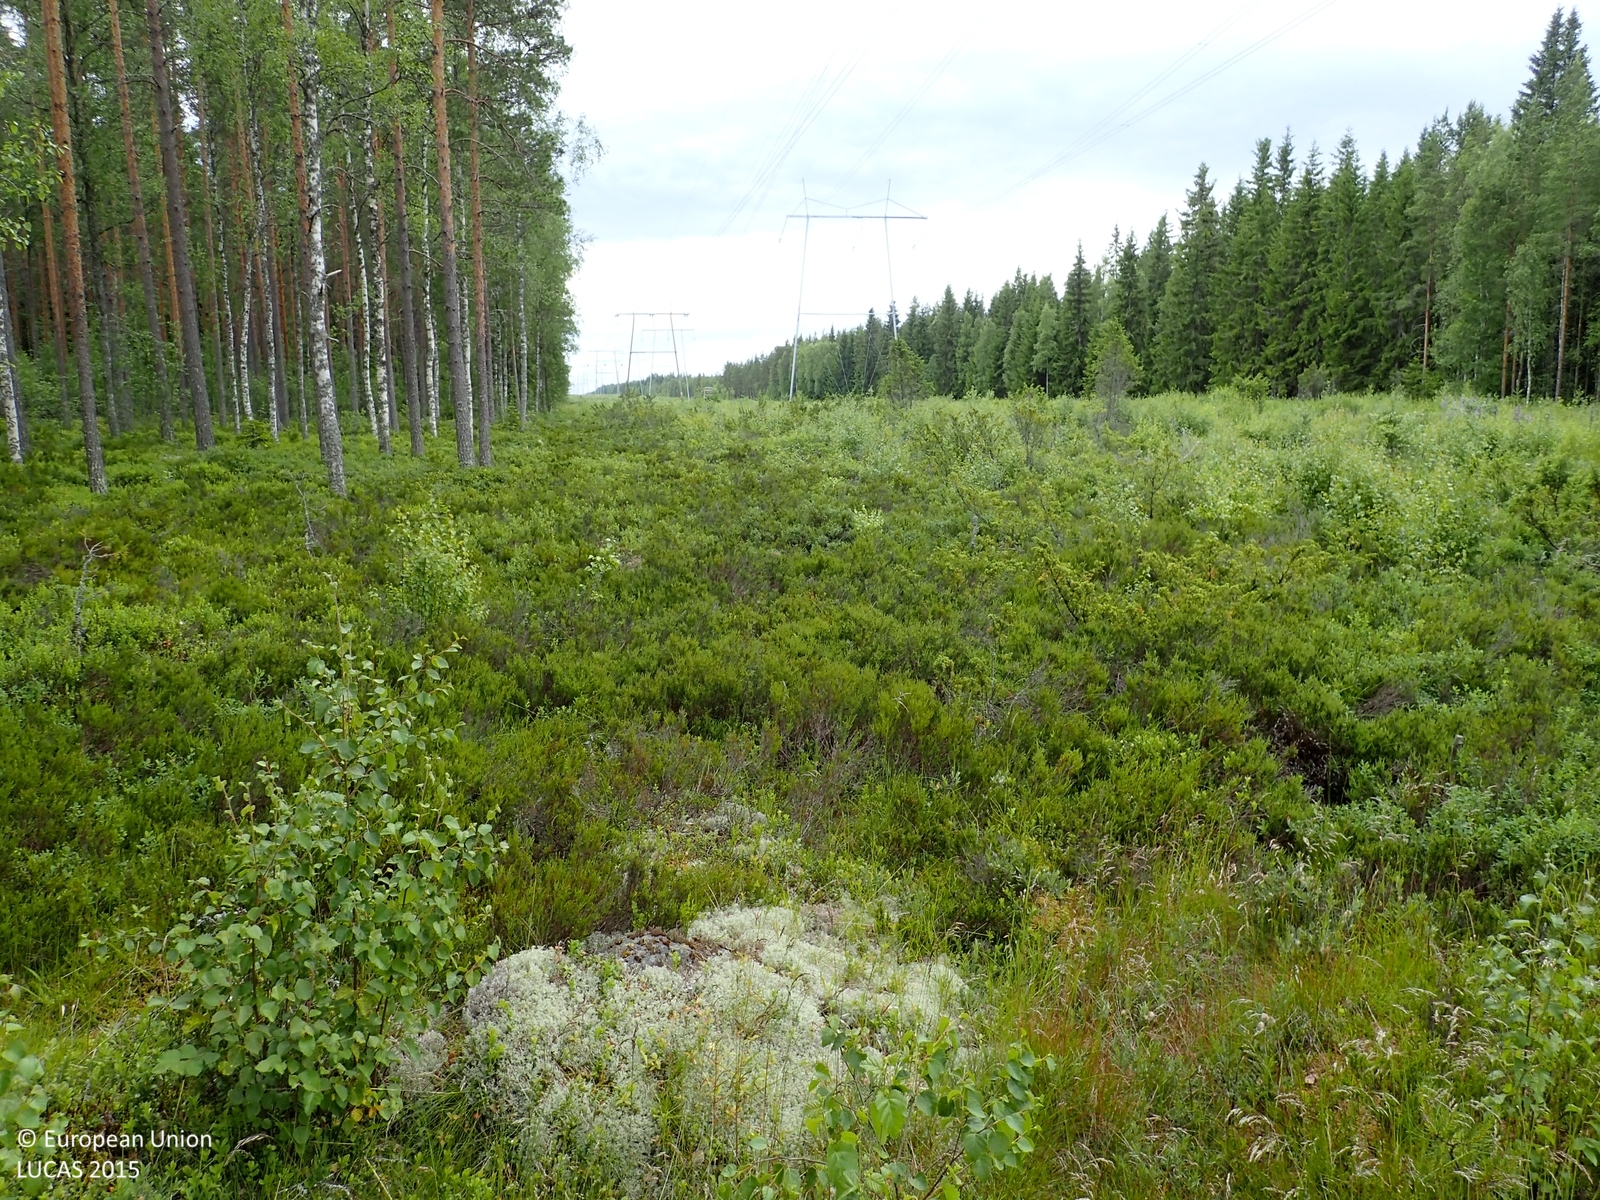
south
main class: Shrubland
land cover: Shrubland with sparse tree cover
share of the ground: > 75 %
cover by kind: shrubs 80 %, herbaceous plants 10 %, broadleaved forest trees 5 %, lichens and mosses 5 %
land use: Electricity, gas and thermal power distribution
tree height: < 5 m
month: July
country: FI
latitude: 62.7371
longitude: 21.7262
